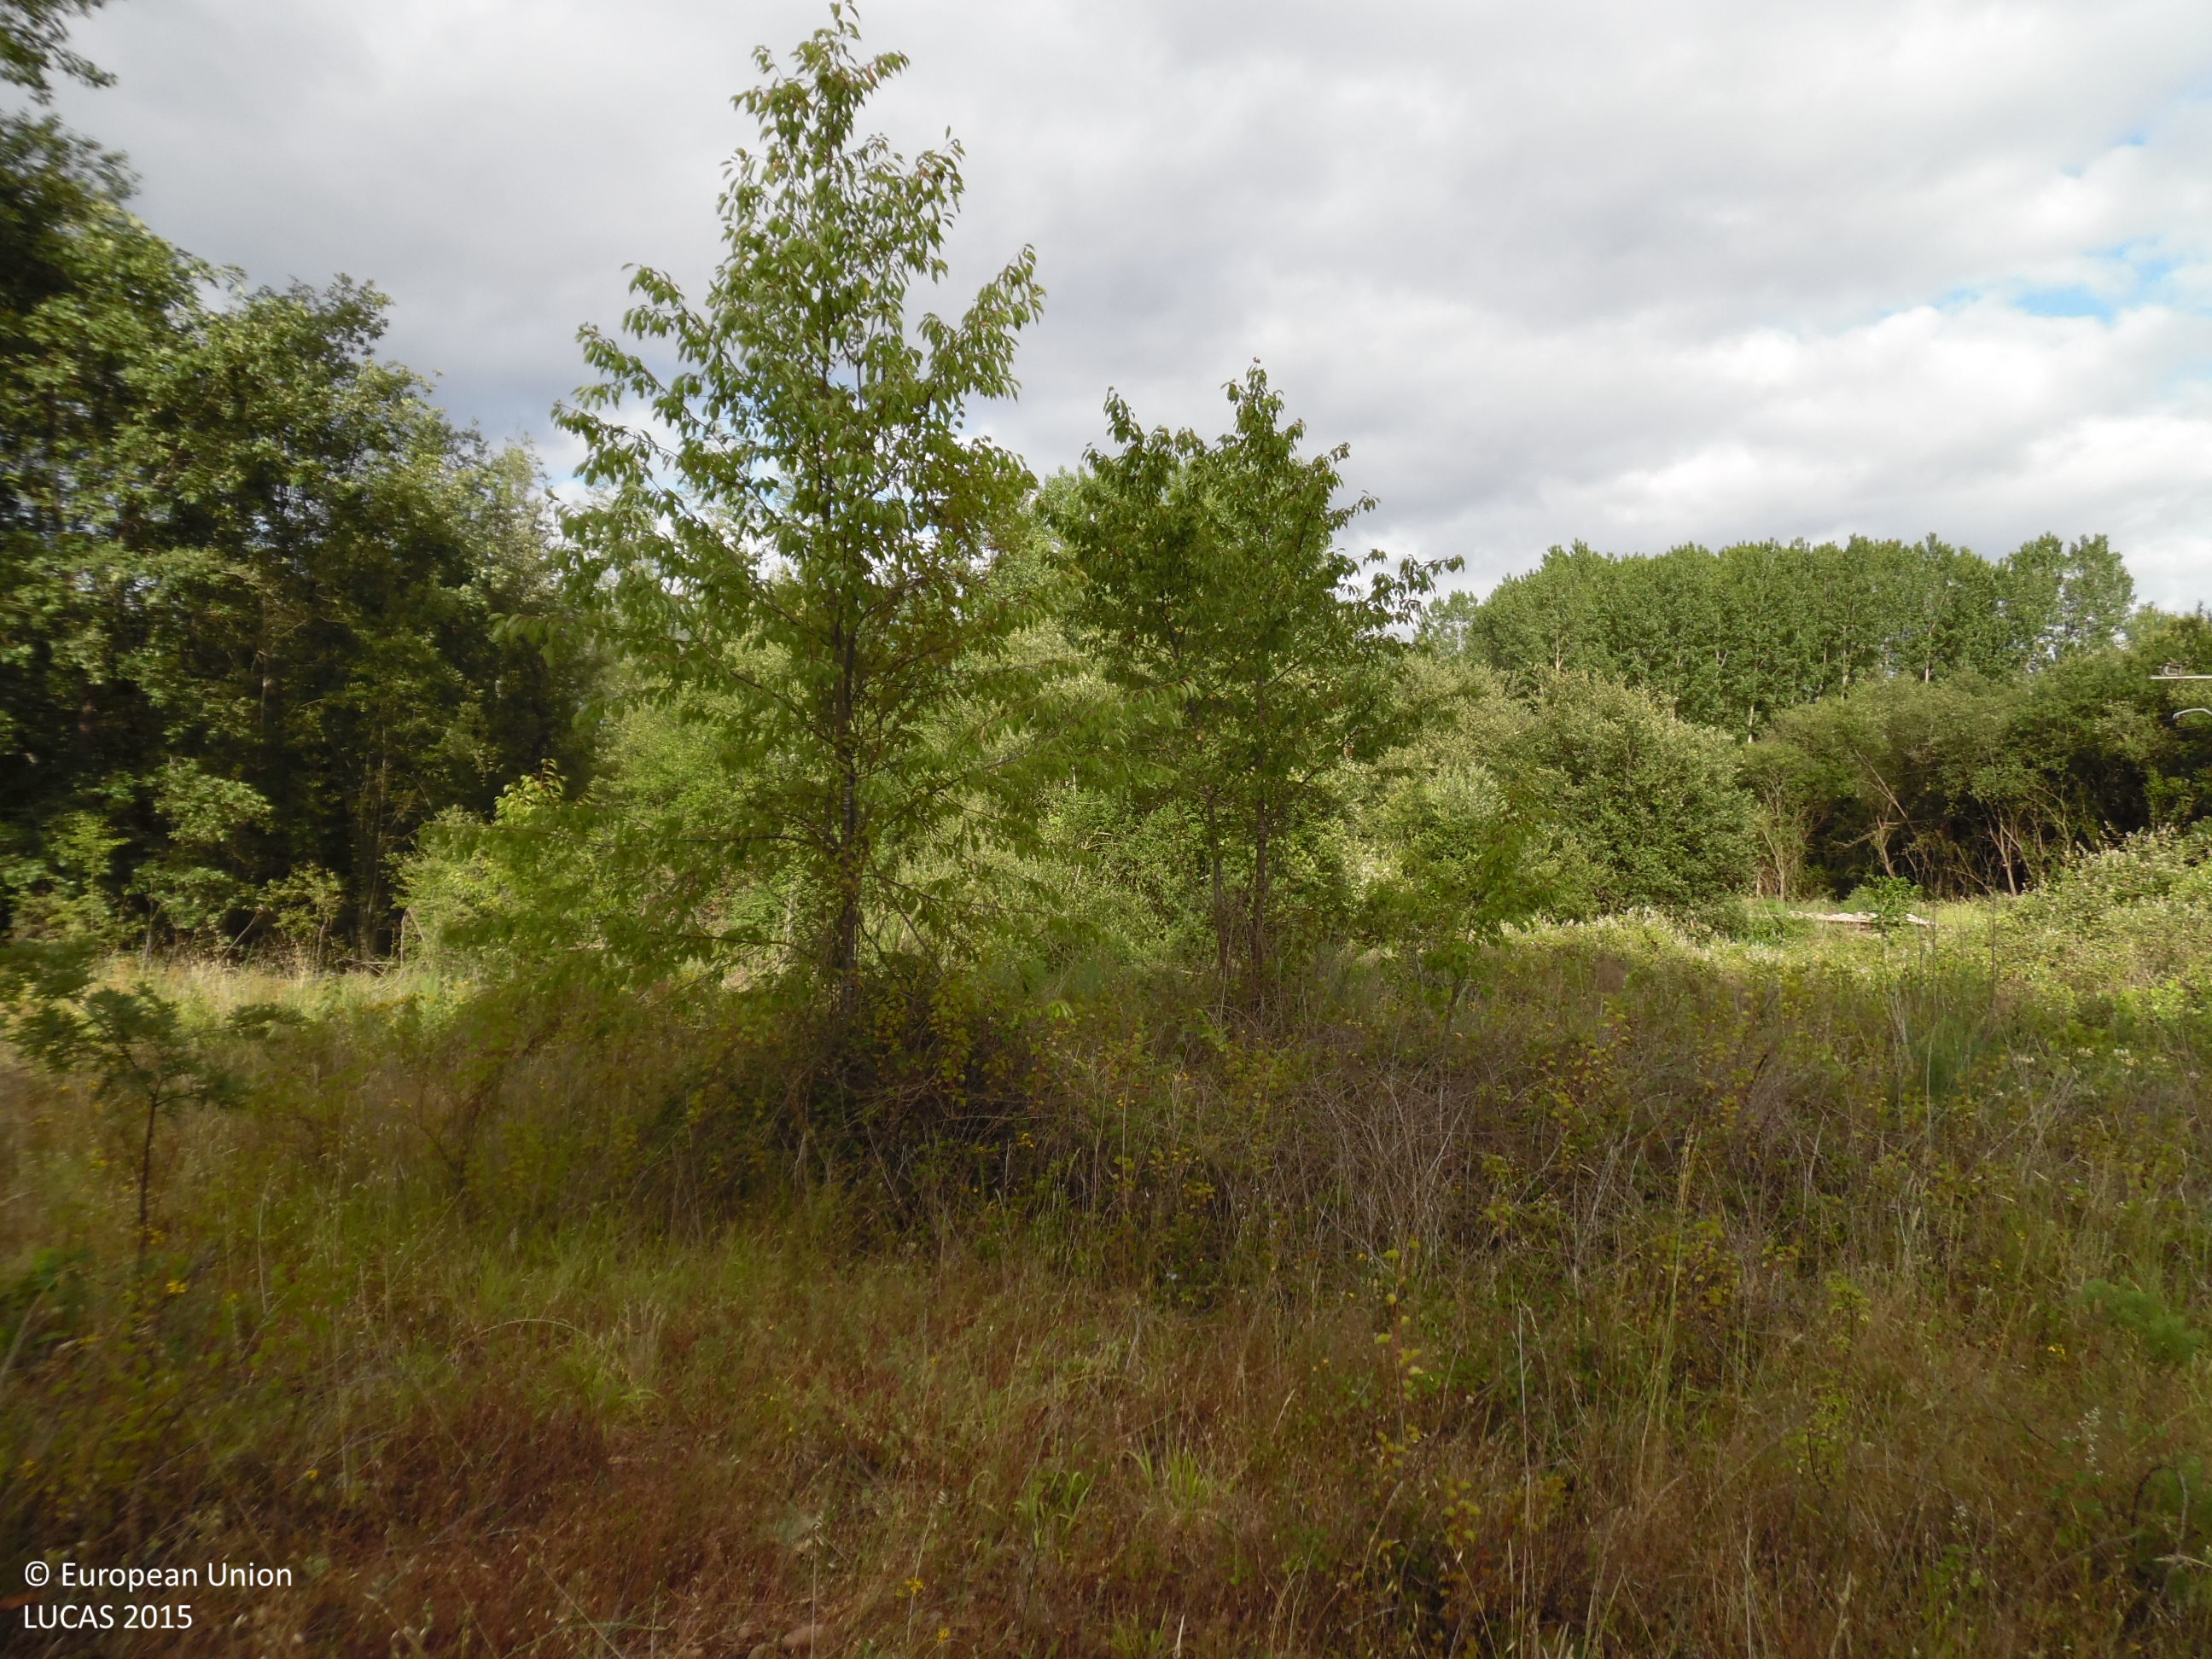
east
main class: Shrubland
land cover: Shrubland with sparse tree cover
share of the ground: > 75 %
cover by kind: shrubs 95 %, broadleaved forest trees 5 %
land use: Abandoned areas
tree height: > 5 m
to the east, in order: Shrubland with sparse tree cover; Broadleaved woodland; Grass margins; Tracks; Railways; Electric lines; Ditches and canals; Grassland with sparse tree/shrub cover
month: June
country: ES
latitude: 42.5369
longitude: -6.7428
